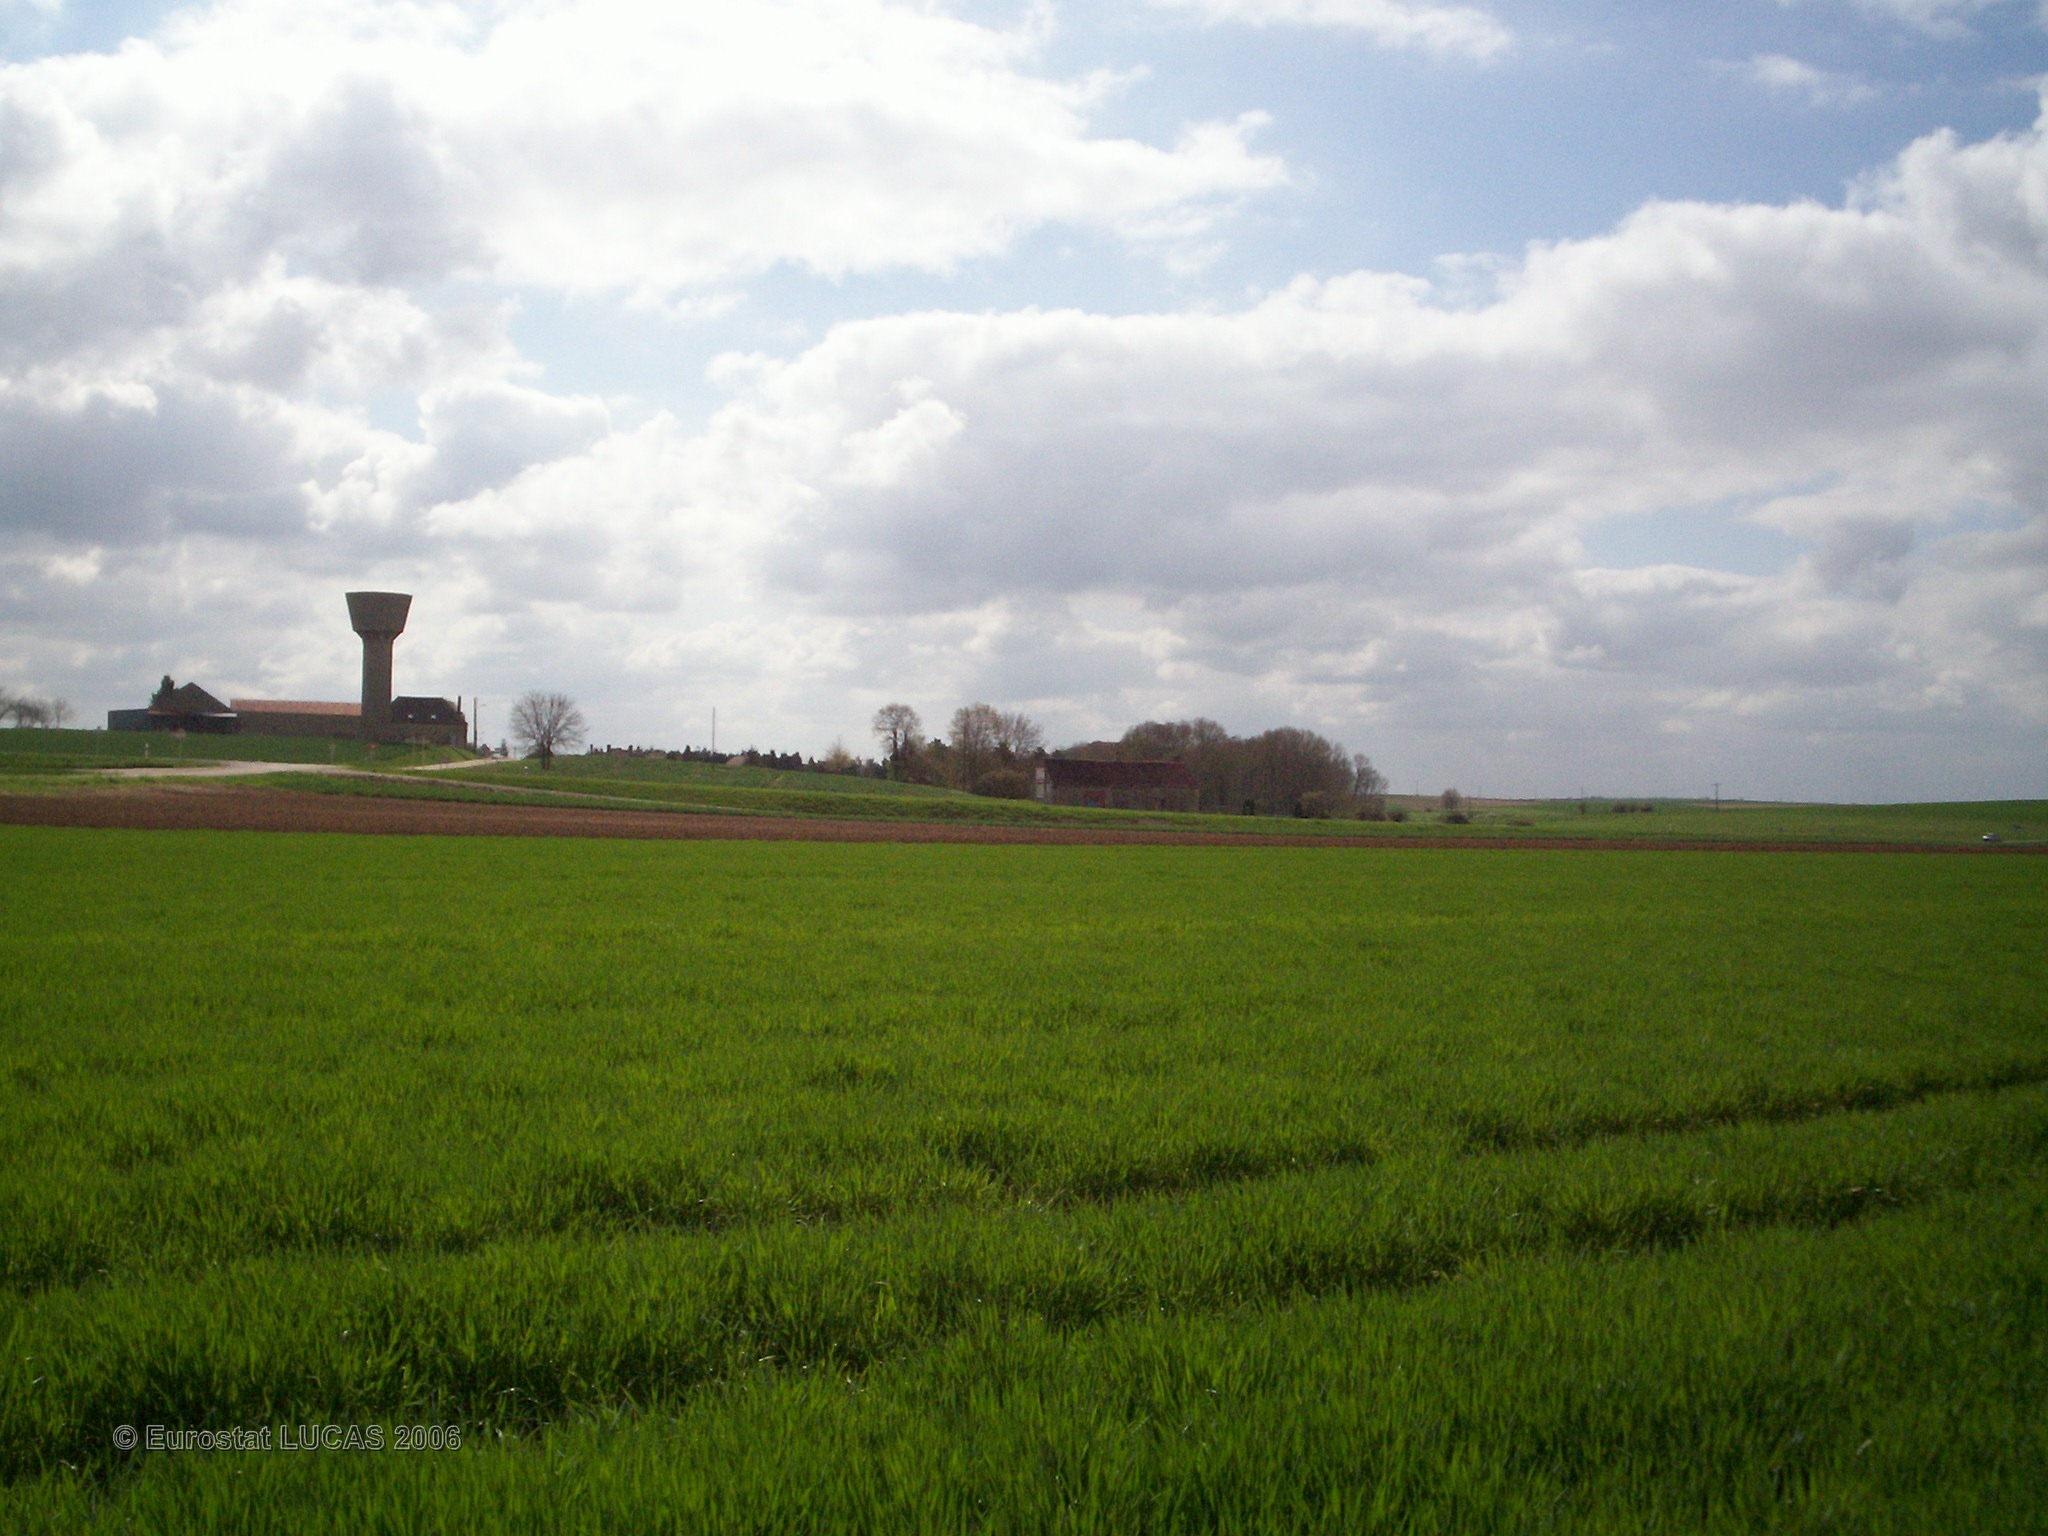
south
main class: Cropland
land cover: Barley
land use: Agriculture (excluding fallow land and kitchen gardens)
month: April
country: FR
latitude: 48.0676
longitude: 3.8093
